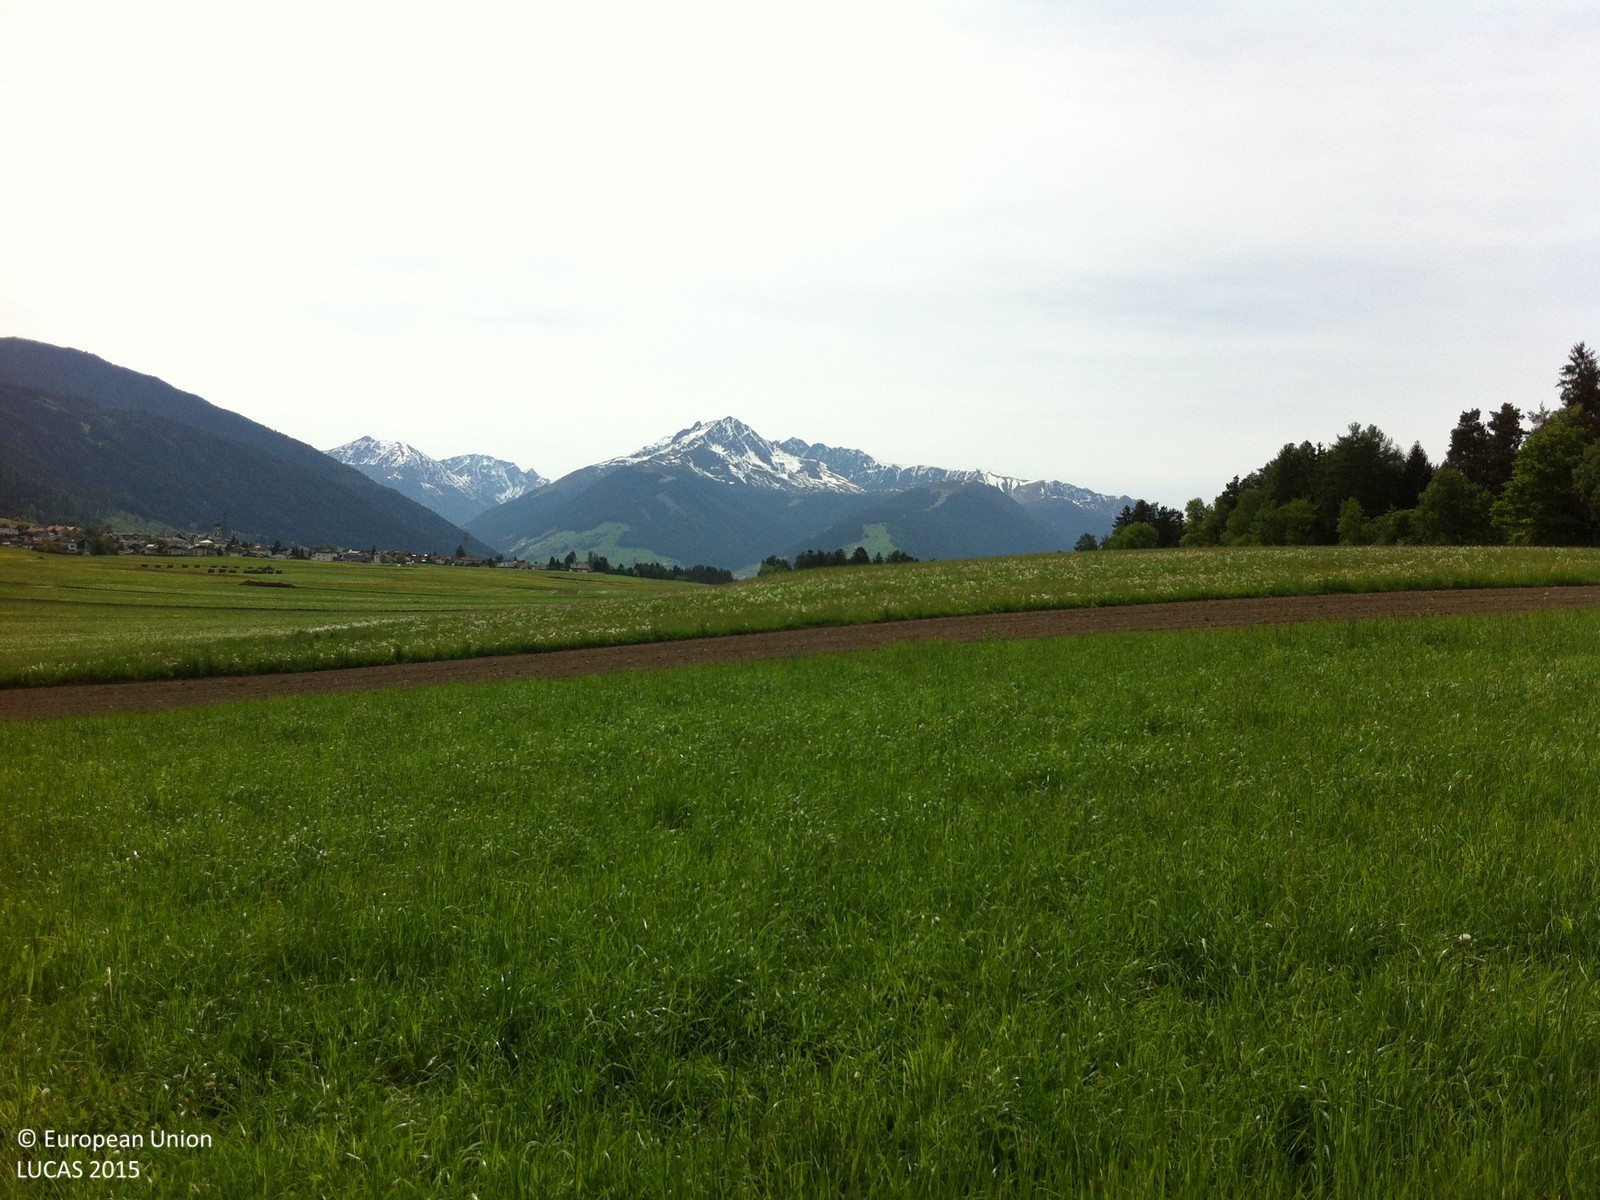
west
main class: Cropland
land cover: Temporary grasslands
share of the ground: > 75 %
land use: Agriculture (excluding fallow land and kitchen gardens)
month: May
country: AT
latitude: 47.2434
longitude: 11.3331
